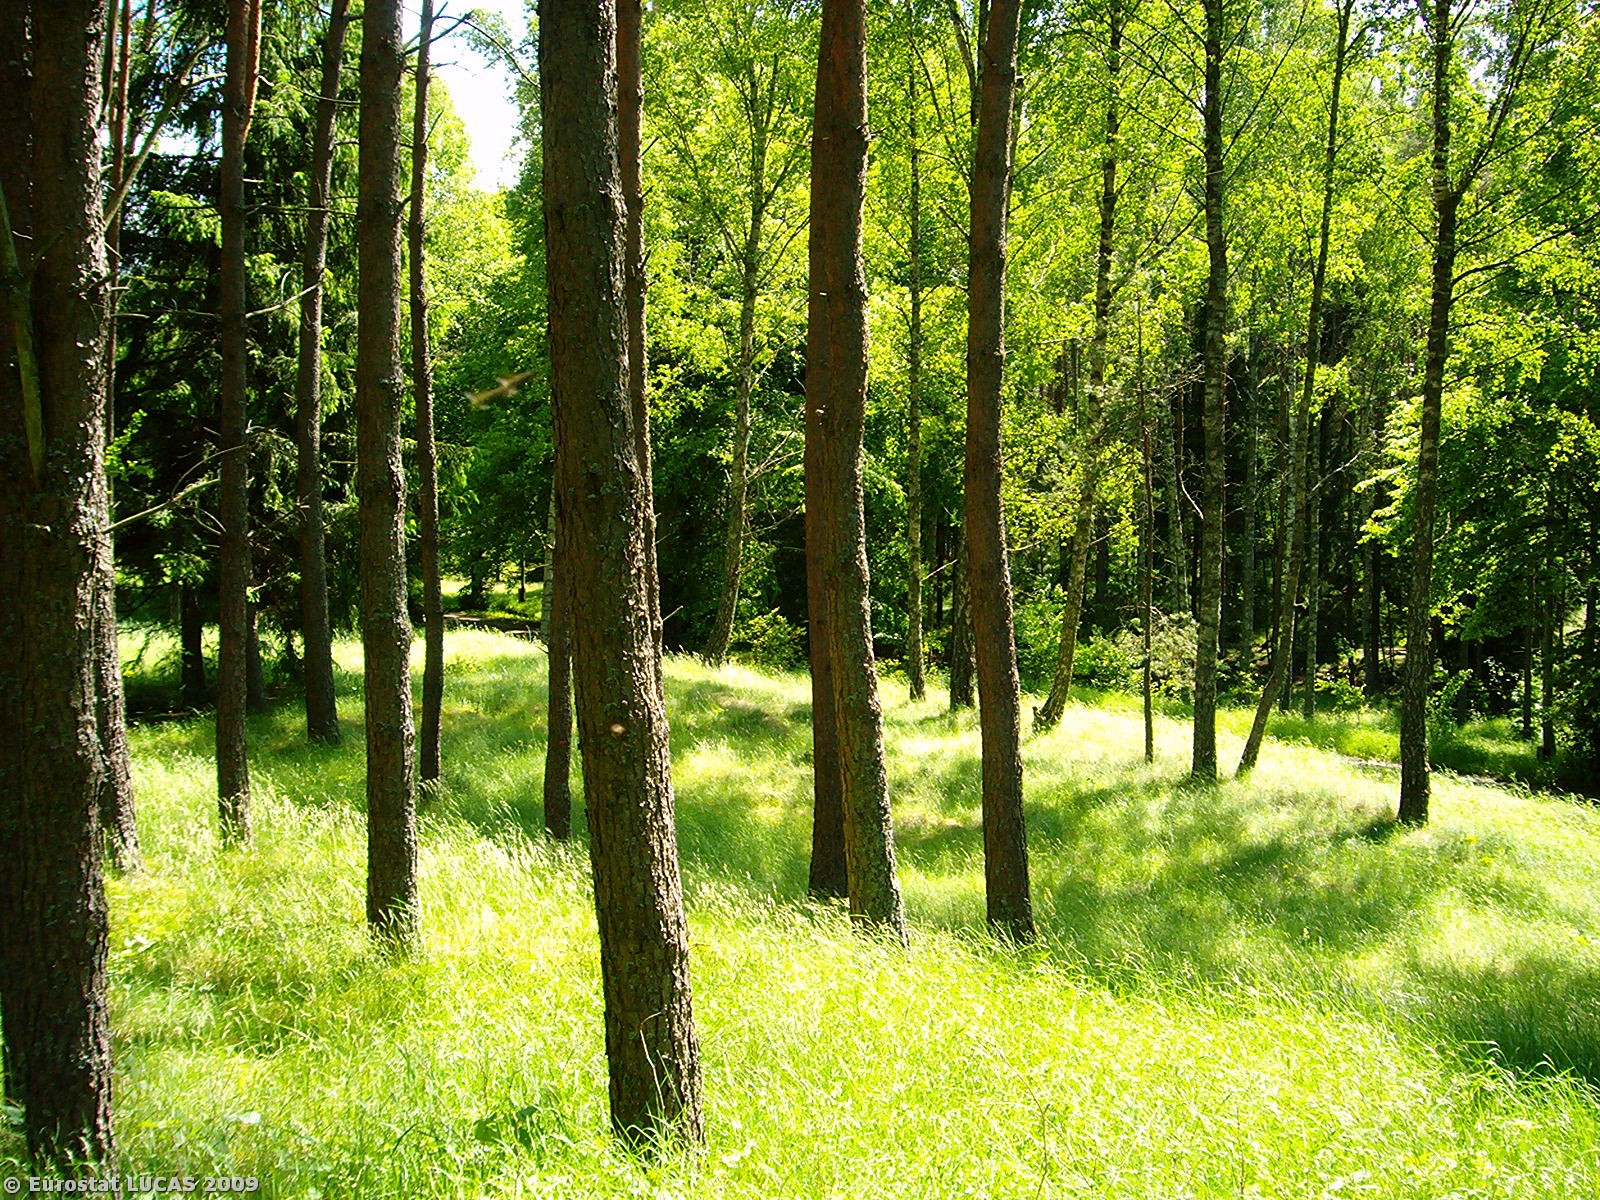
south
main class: Woodland
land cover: Mixed woodland
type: hemiboreal forest and nemoral coniferous forest and mixed broadleaved-coniferous forest
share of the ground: 50 - 75 %
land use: Forestry
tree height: > 5 m
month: June
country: PL
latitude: 53.9447
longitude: 17.2160
